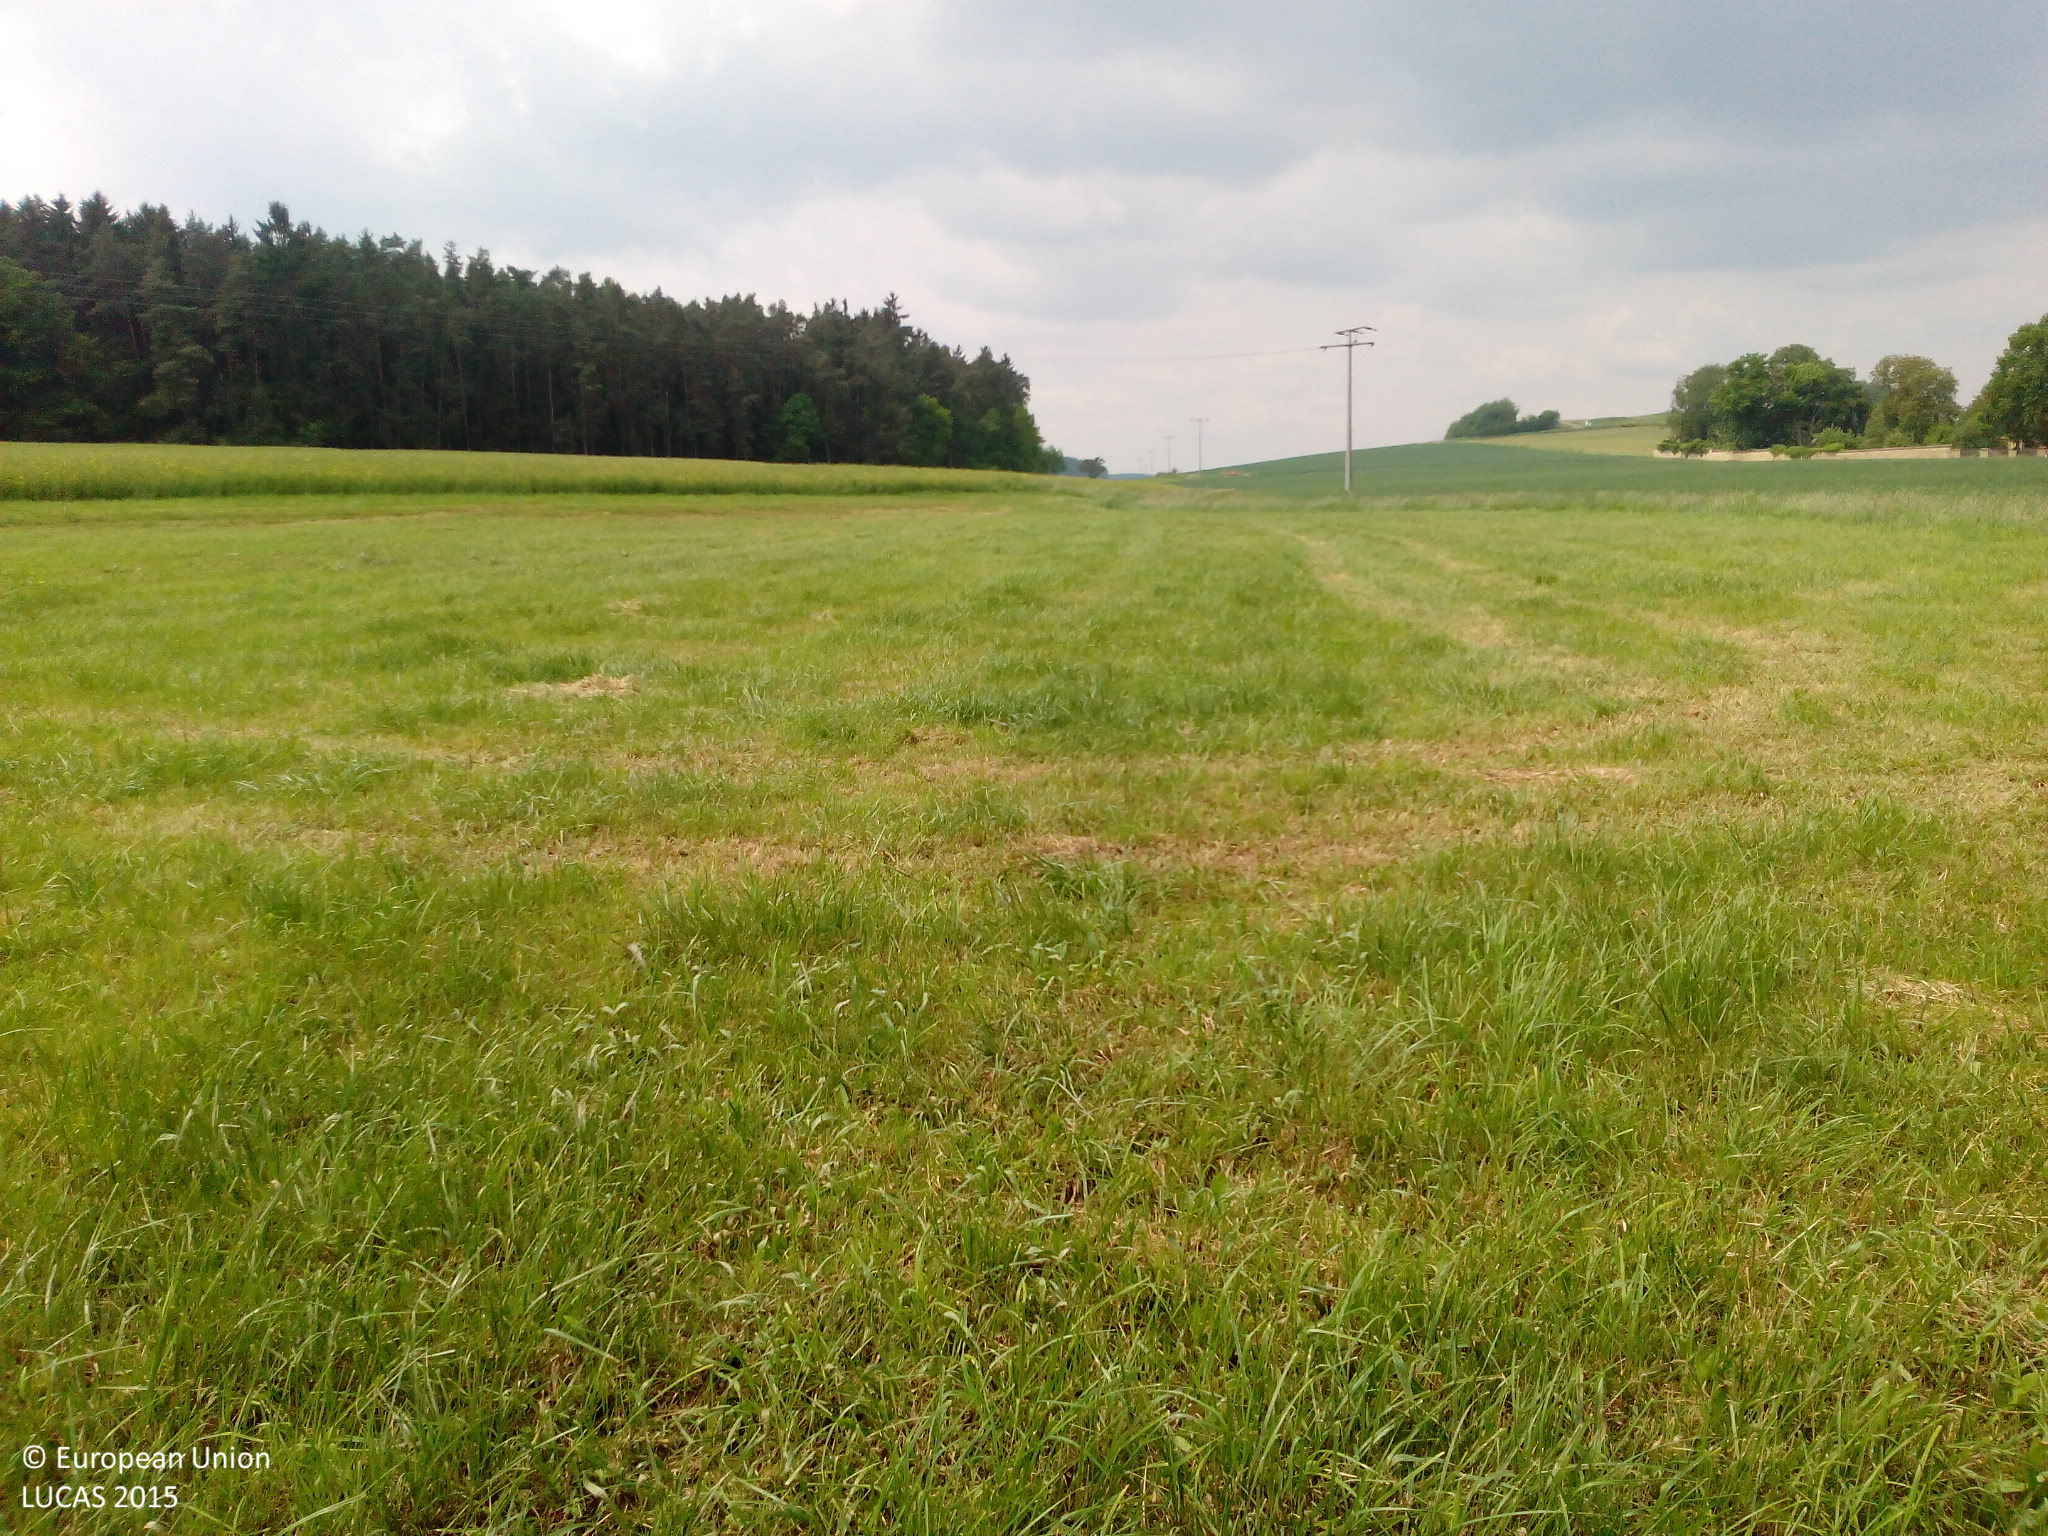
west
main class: Grassland
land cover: Grassland without tree/shrub cover
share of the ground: > 75 %
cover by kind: herbaceous plants 95 %, unconsolidated bare surface 5 %
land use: Agriculture (excluding fallow land and kitchen gardens)
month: May
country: DE
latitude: 49.1395
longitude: 12.0966
